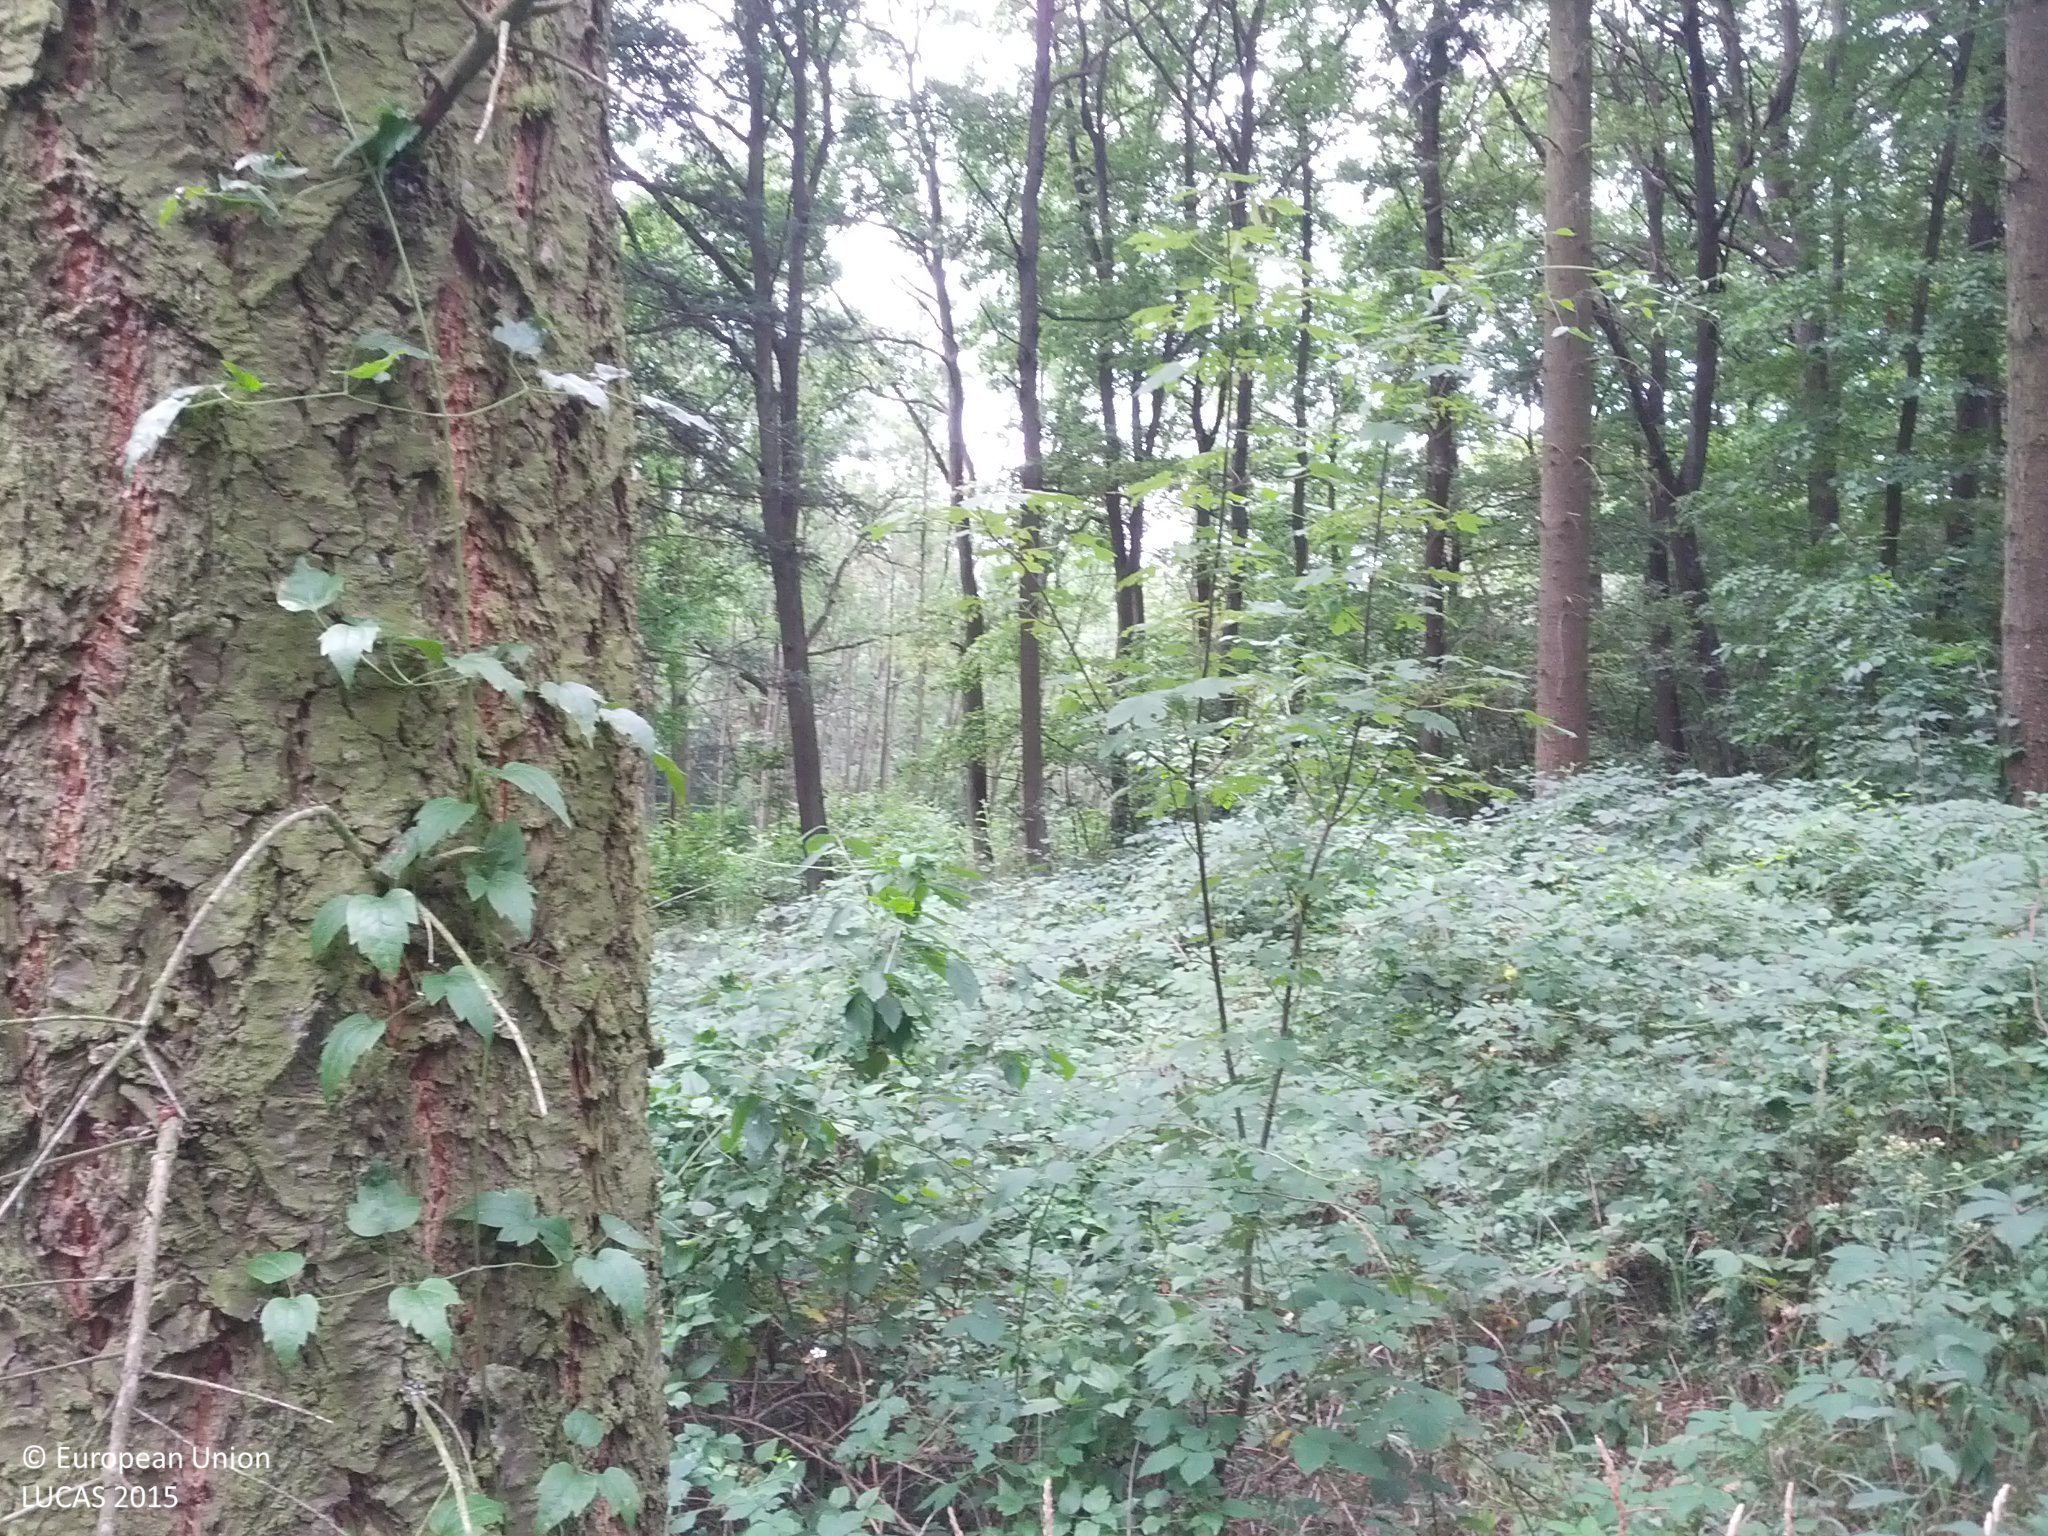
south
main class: Woodland
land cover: Pine dominated coniferous woodland
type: hemiboreal forest and nemoral coniferous forest and mixed broadleaved-coniferous forest
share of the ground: 50 - 75 %
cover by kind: coniferous forest trees 70 %, shrubs 20 %, herbaceous plants 10 %
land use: Forestry
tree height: > 5 m
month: July
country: AT
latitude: 48.5232
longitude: 16.1111
